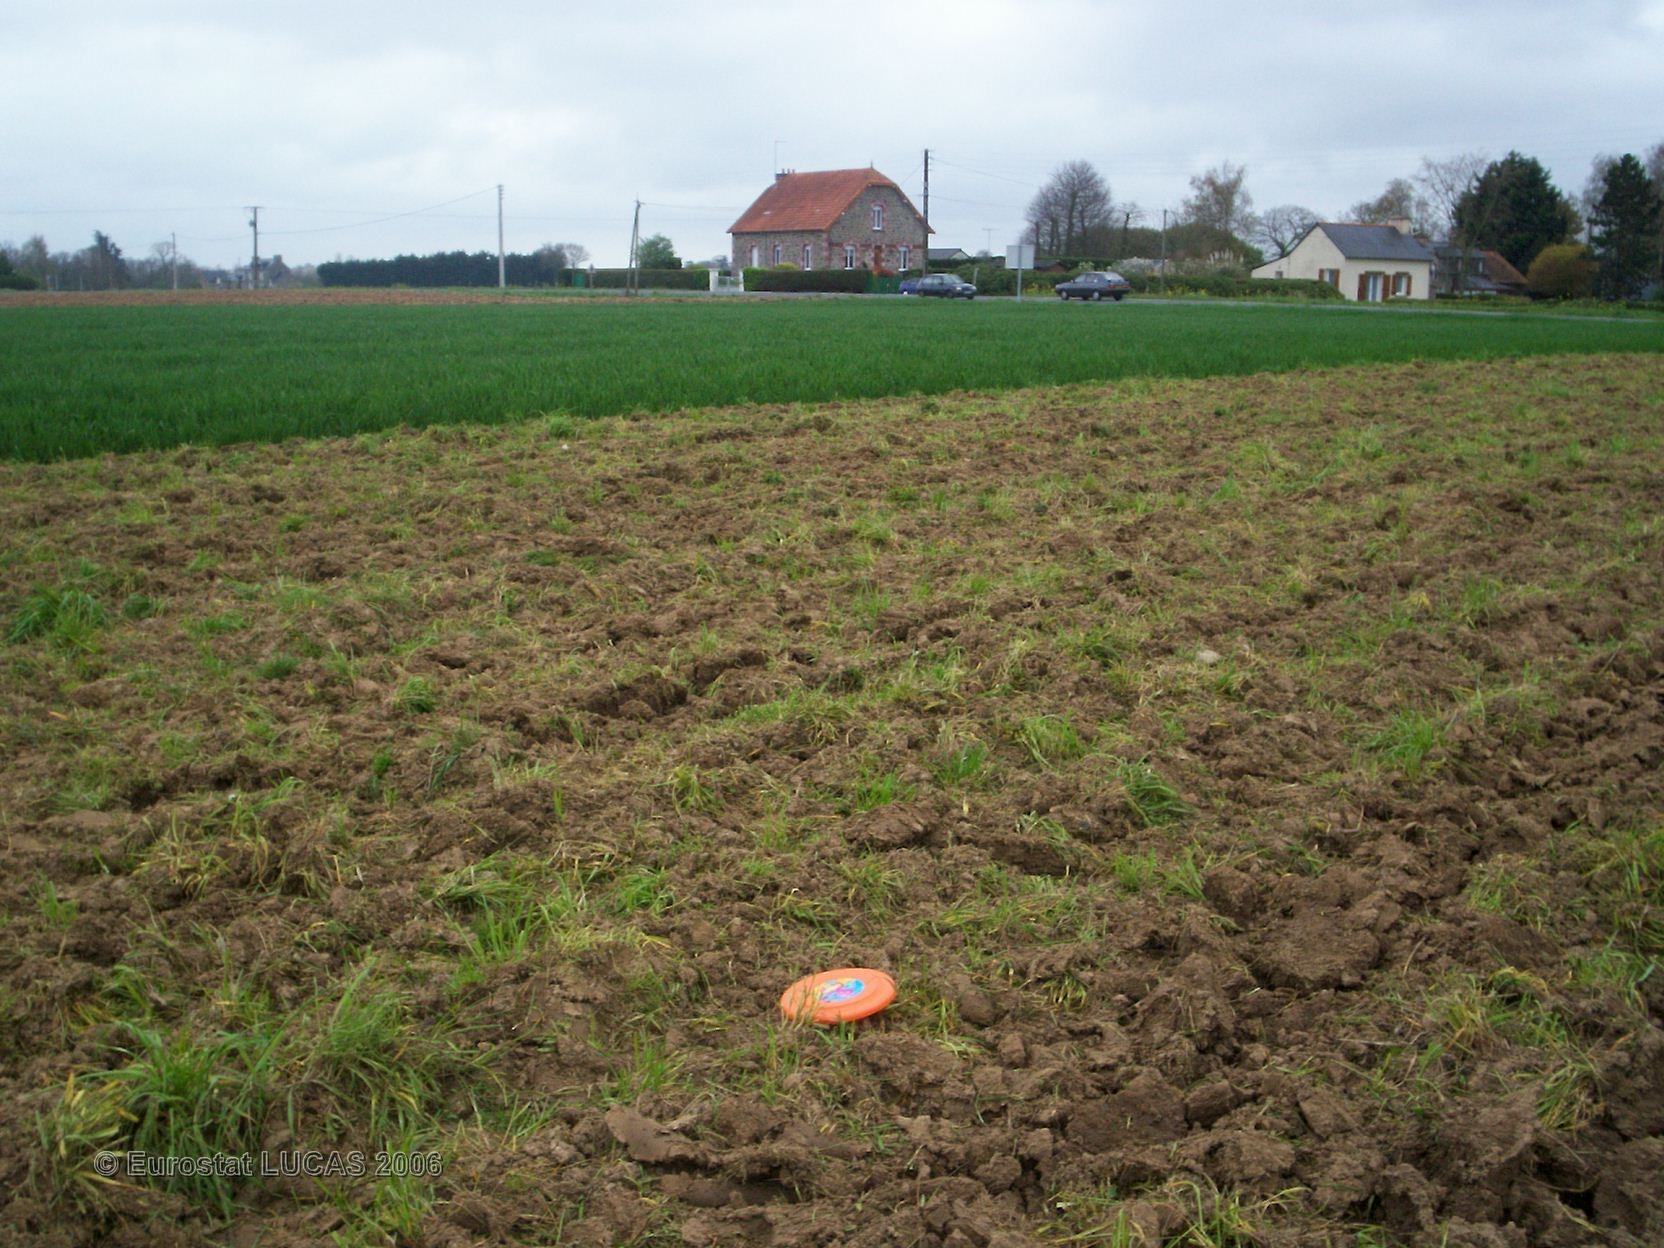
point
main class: Cropland
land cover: Common wheat
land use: Agriculture (excluding fallow land and kitchen gardens)
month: June
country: FR
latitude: 48.4361
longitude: -2.5105
